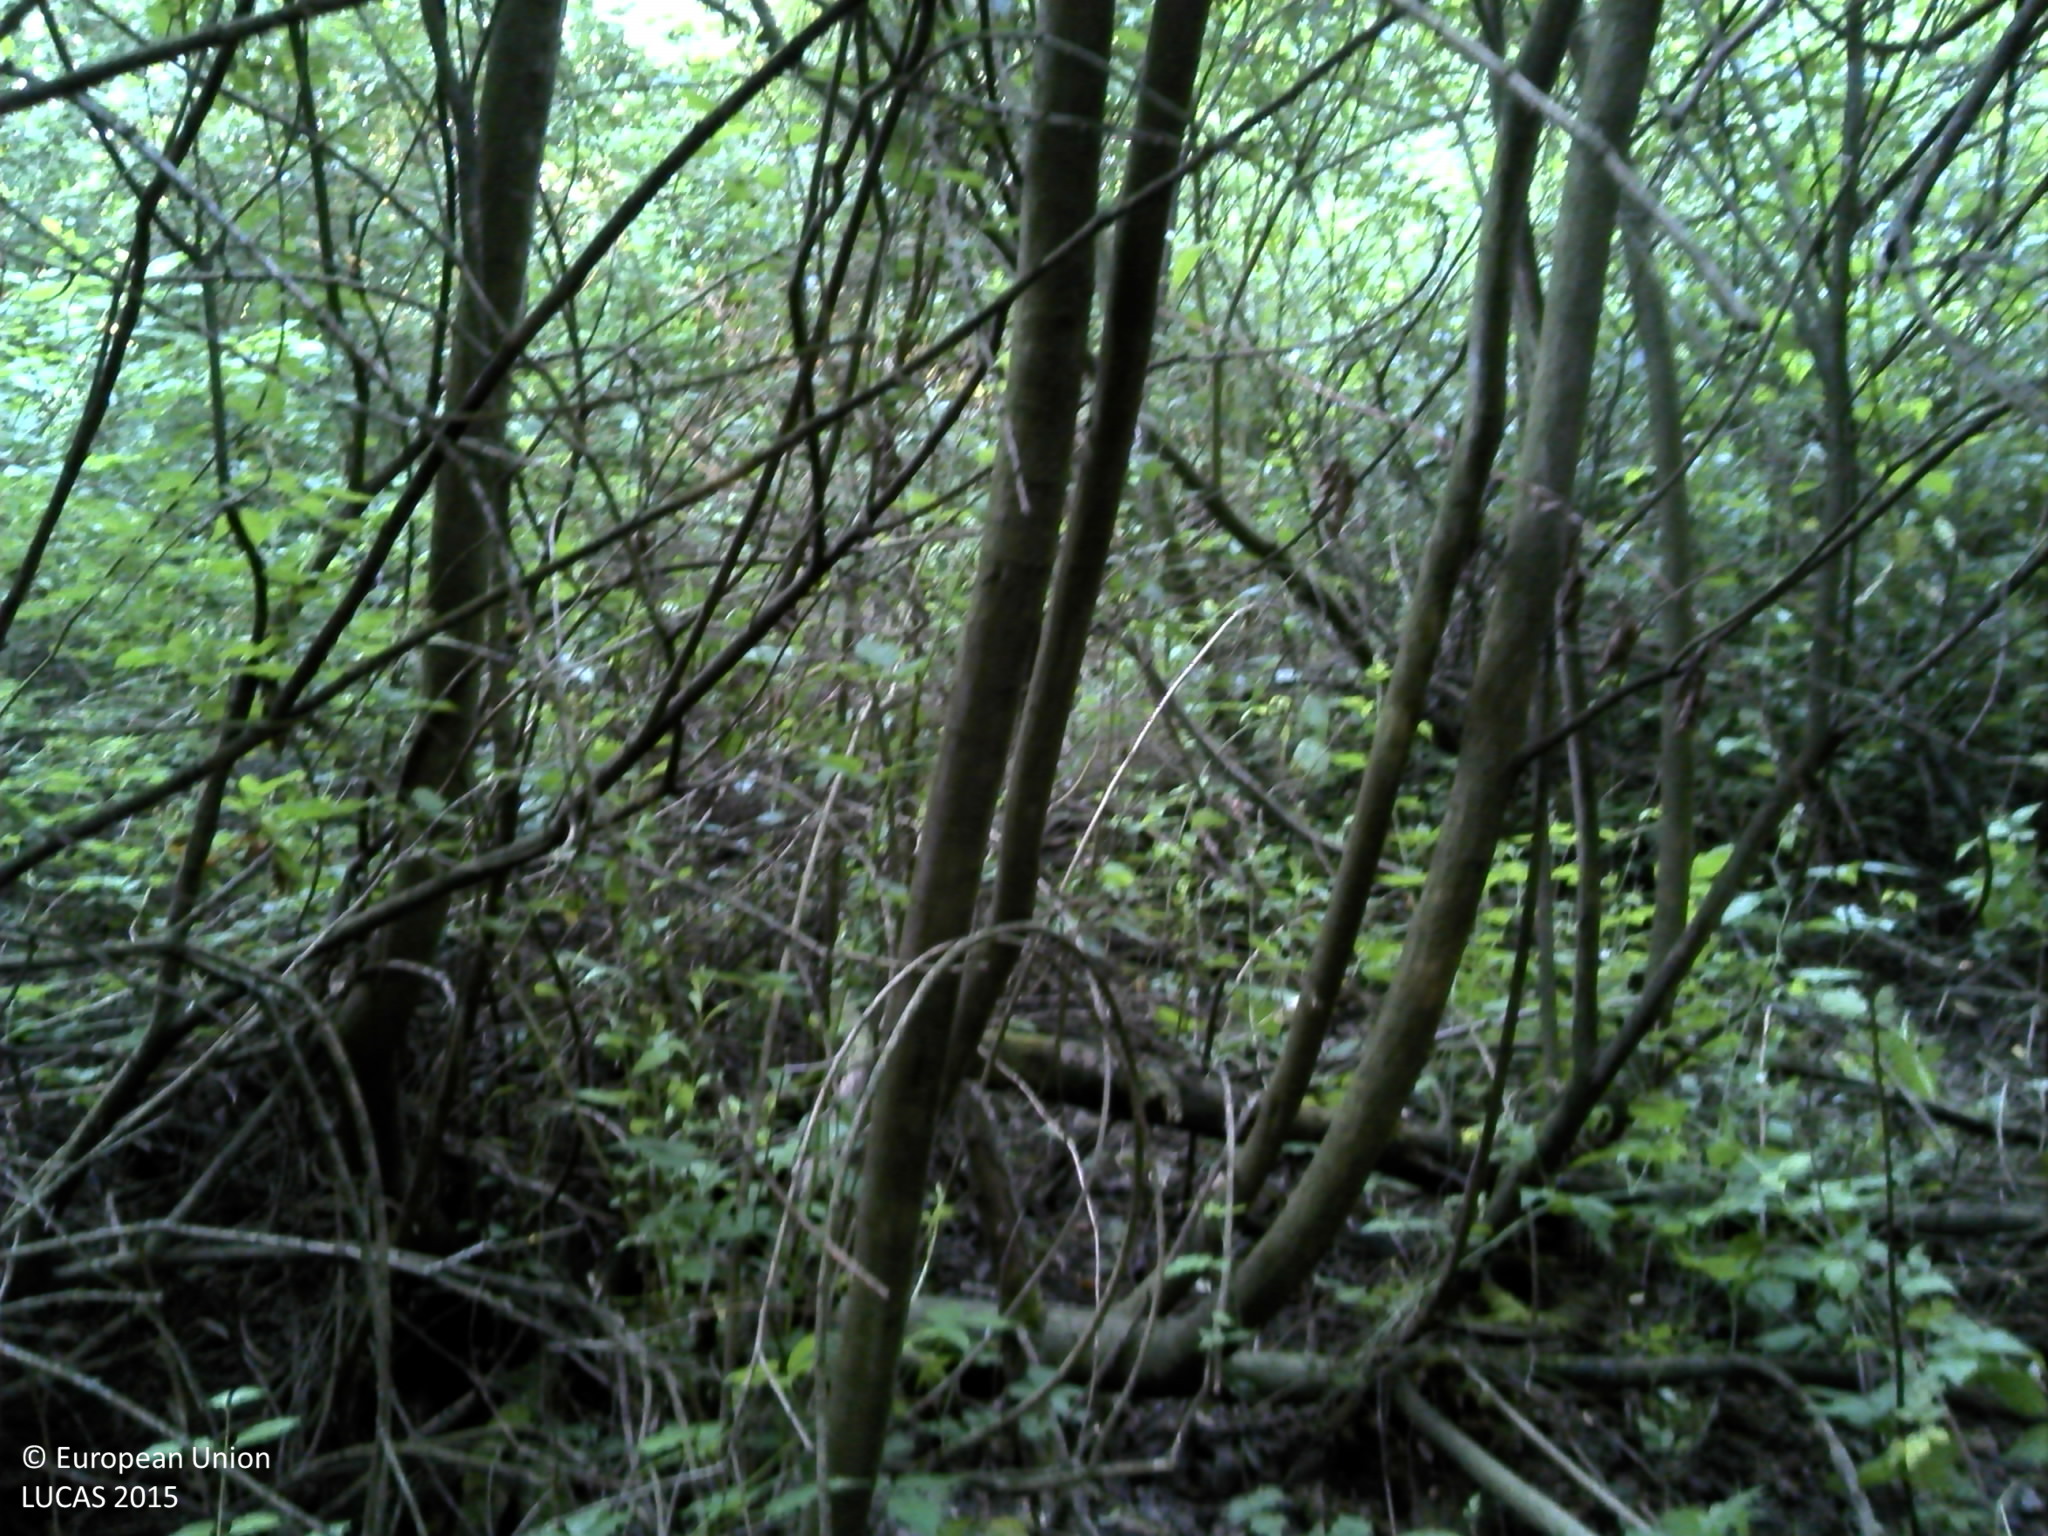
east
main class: Woodland
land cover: Broadleaved woodland
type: mesophytic deciduous forest
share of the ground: > 75 %
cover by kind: broadleaved forest trees 100 %
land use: Semi-natural and natural areas not in use
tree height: > 5 m
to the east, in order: Broadleaved woodland; Ditches and canals; Rye; Oats; Shrubland with sparse tree cover; Maize; Common wheat; Maize; Tracks; Ditches and canals; Tracks; Spontaneously vegetated surfaces
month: June
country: HR
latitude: 45.4364
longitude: 18.4556
